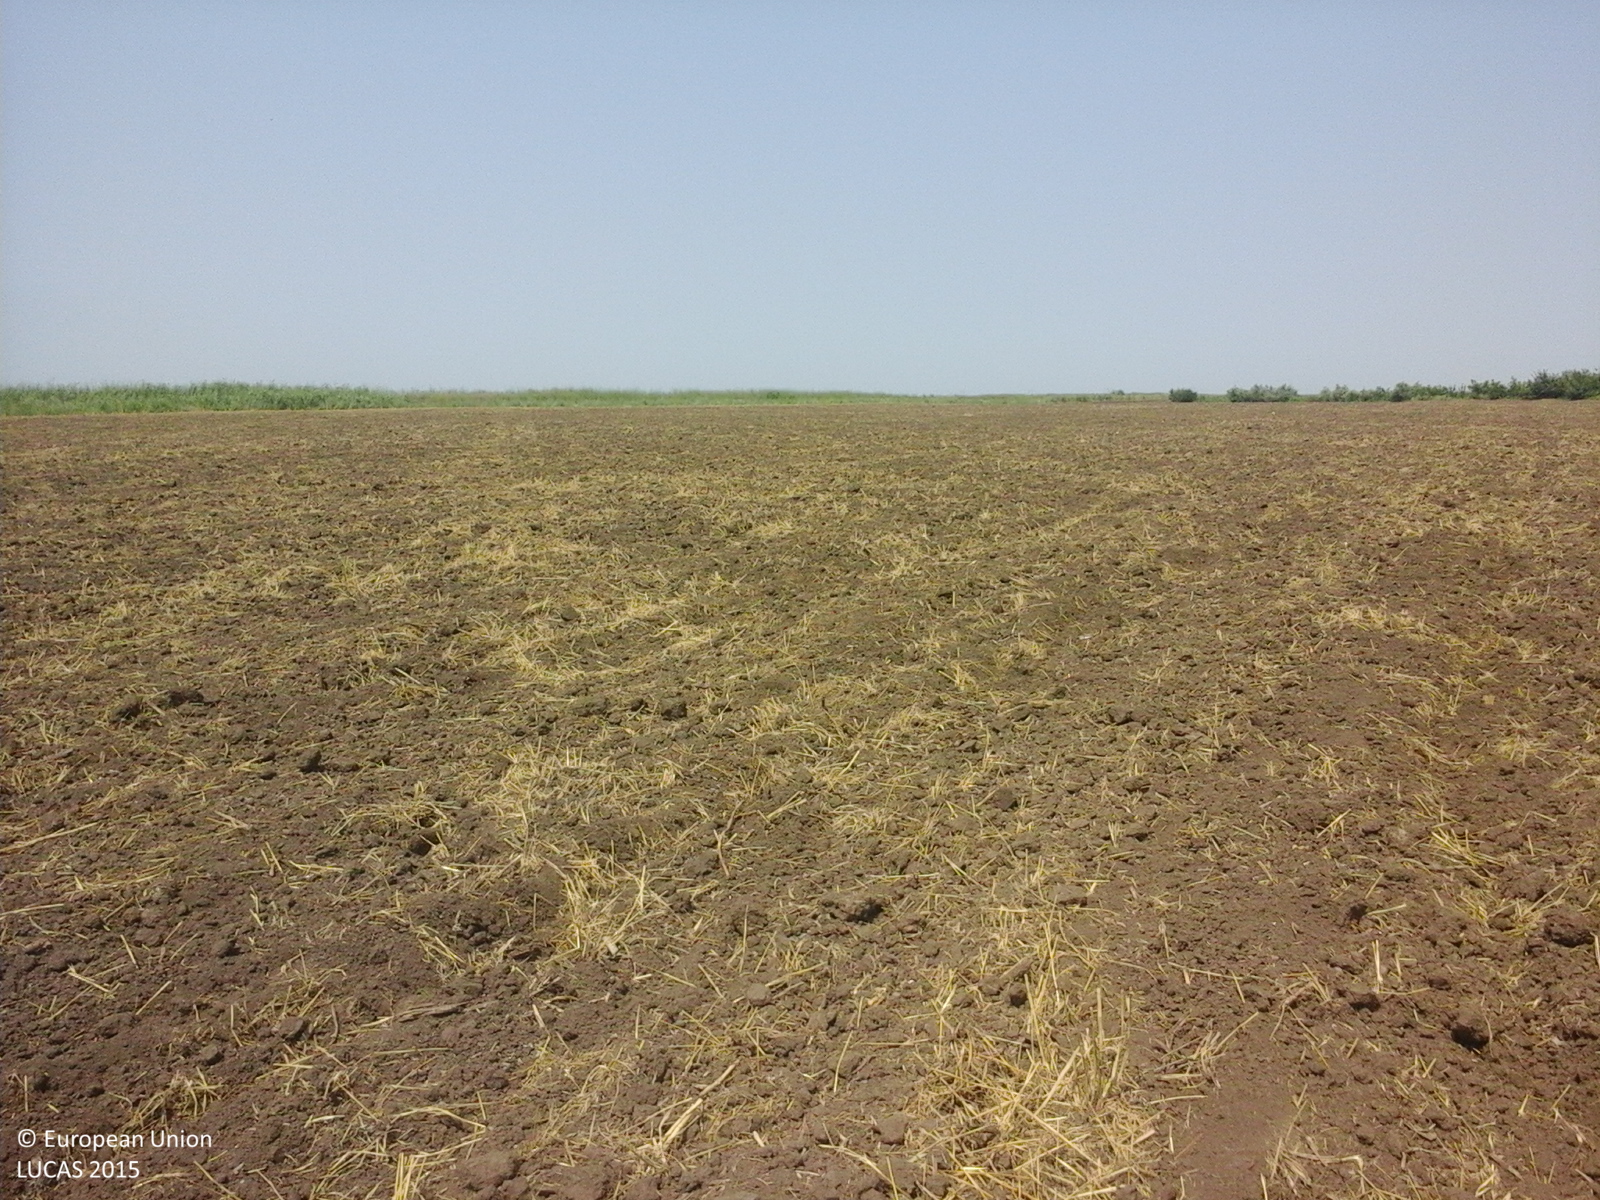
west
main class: Cropland
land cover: Common wheat
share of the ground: < 10 %
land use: Agriculture (excluding fallow land and kitchen gardens)
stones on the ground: < 10 %
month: July
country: RO
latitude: 44.5271
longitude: 26.7183
